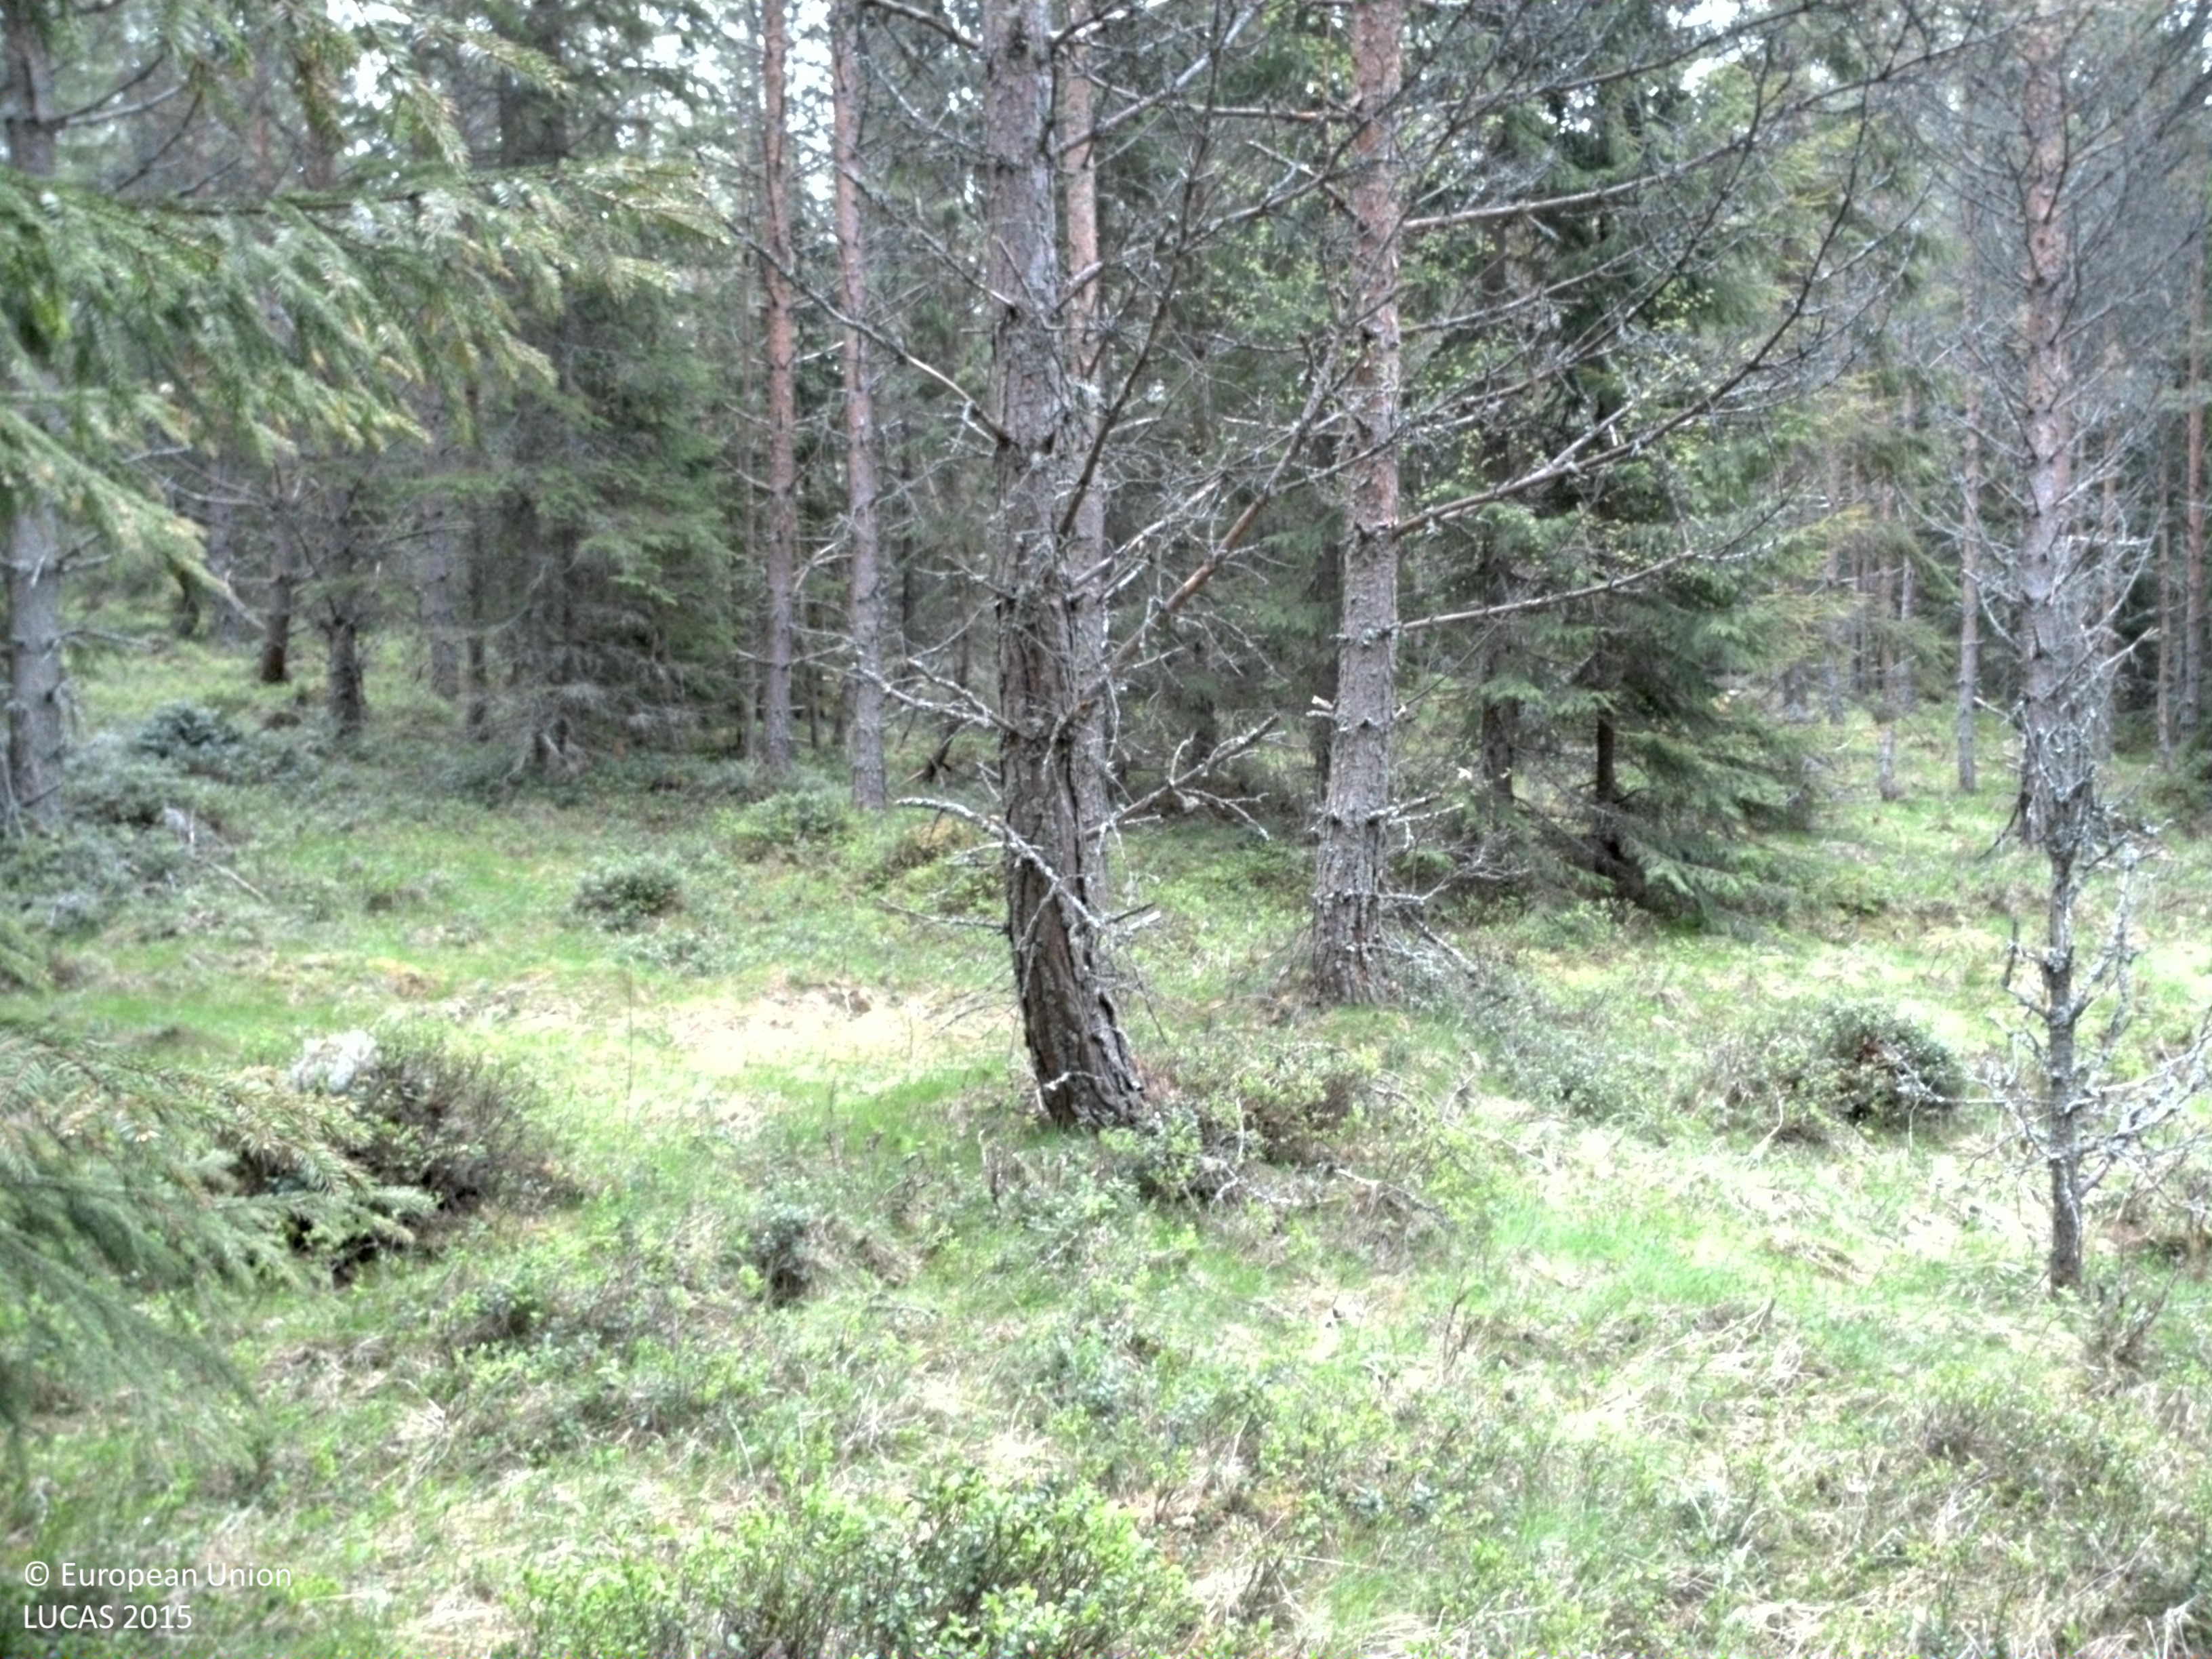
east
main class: Woodland
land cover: Pine dominated coniferous woodland
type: boreal forest
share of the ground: 25 - 50 %
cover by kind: herbaceous plants 65 %, coniferous forest trees 35 %
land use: Forestry
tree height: > 5 m
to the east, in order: Pine dominated coniferous woodland; Spruce dominated coniferous woodland; Spruce dominated mixed woodland; Spruce dominated coniferous woodland; Pine dominated coniferous woodland; Ditches and canals; Pine dominated coniferous woodland; Spruce dominated coniferous woodland; Pine dominated coniferous woodland
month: May
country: SE
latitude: 61.1801
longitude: 15.3595
